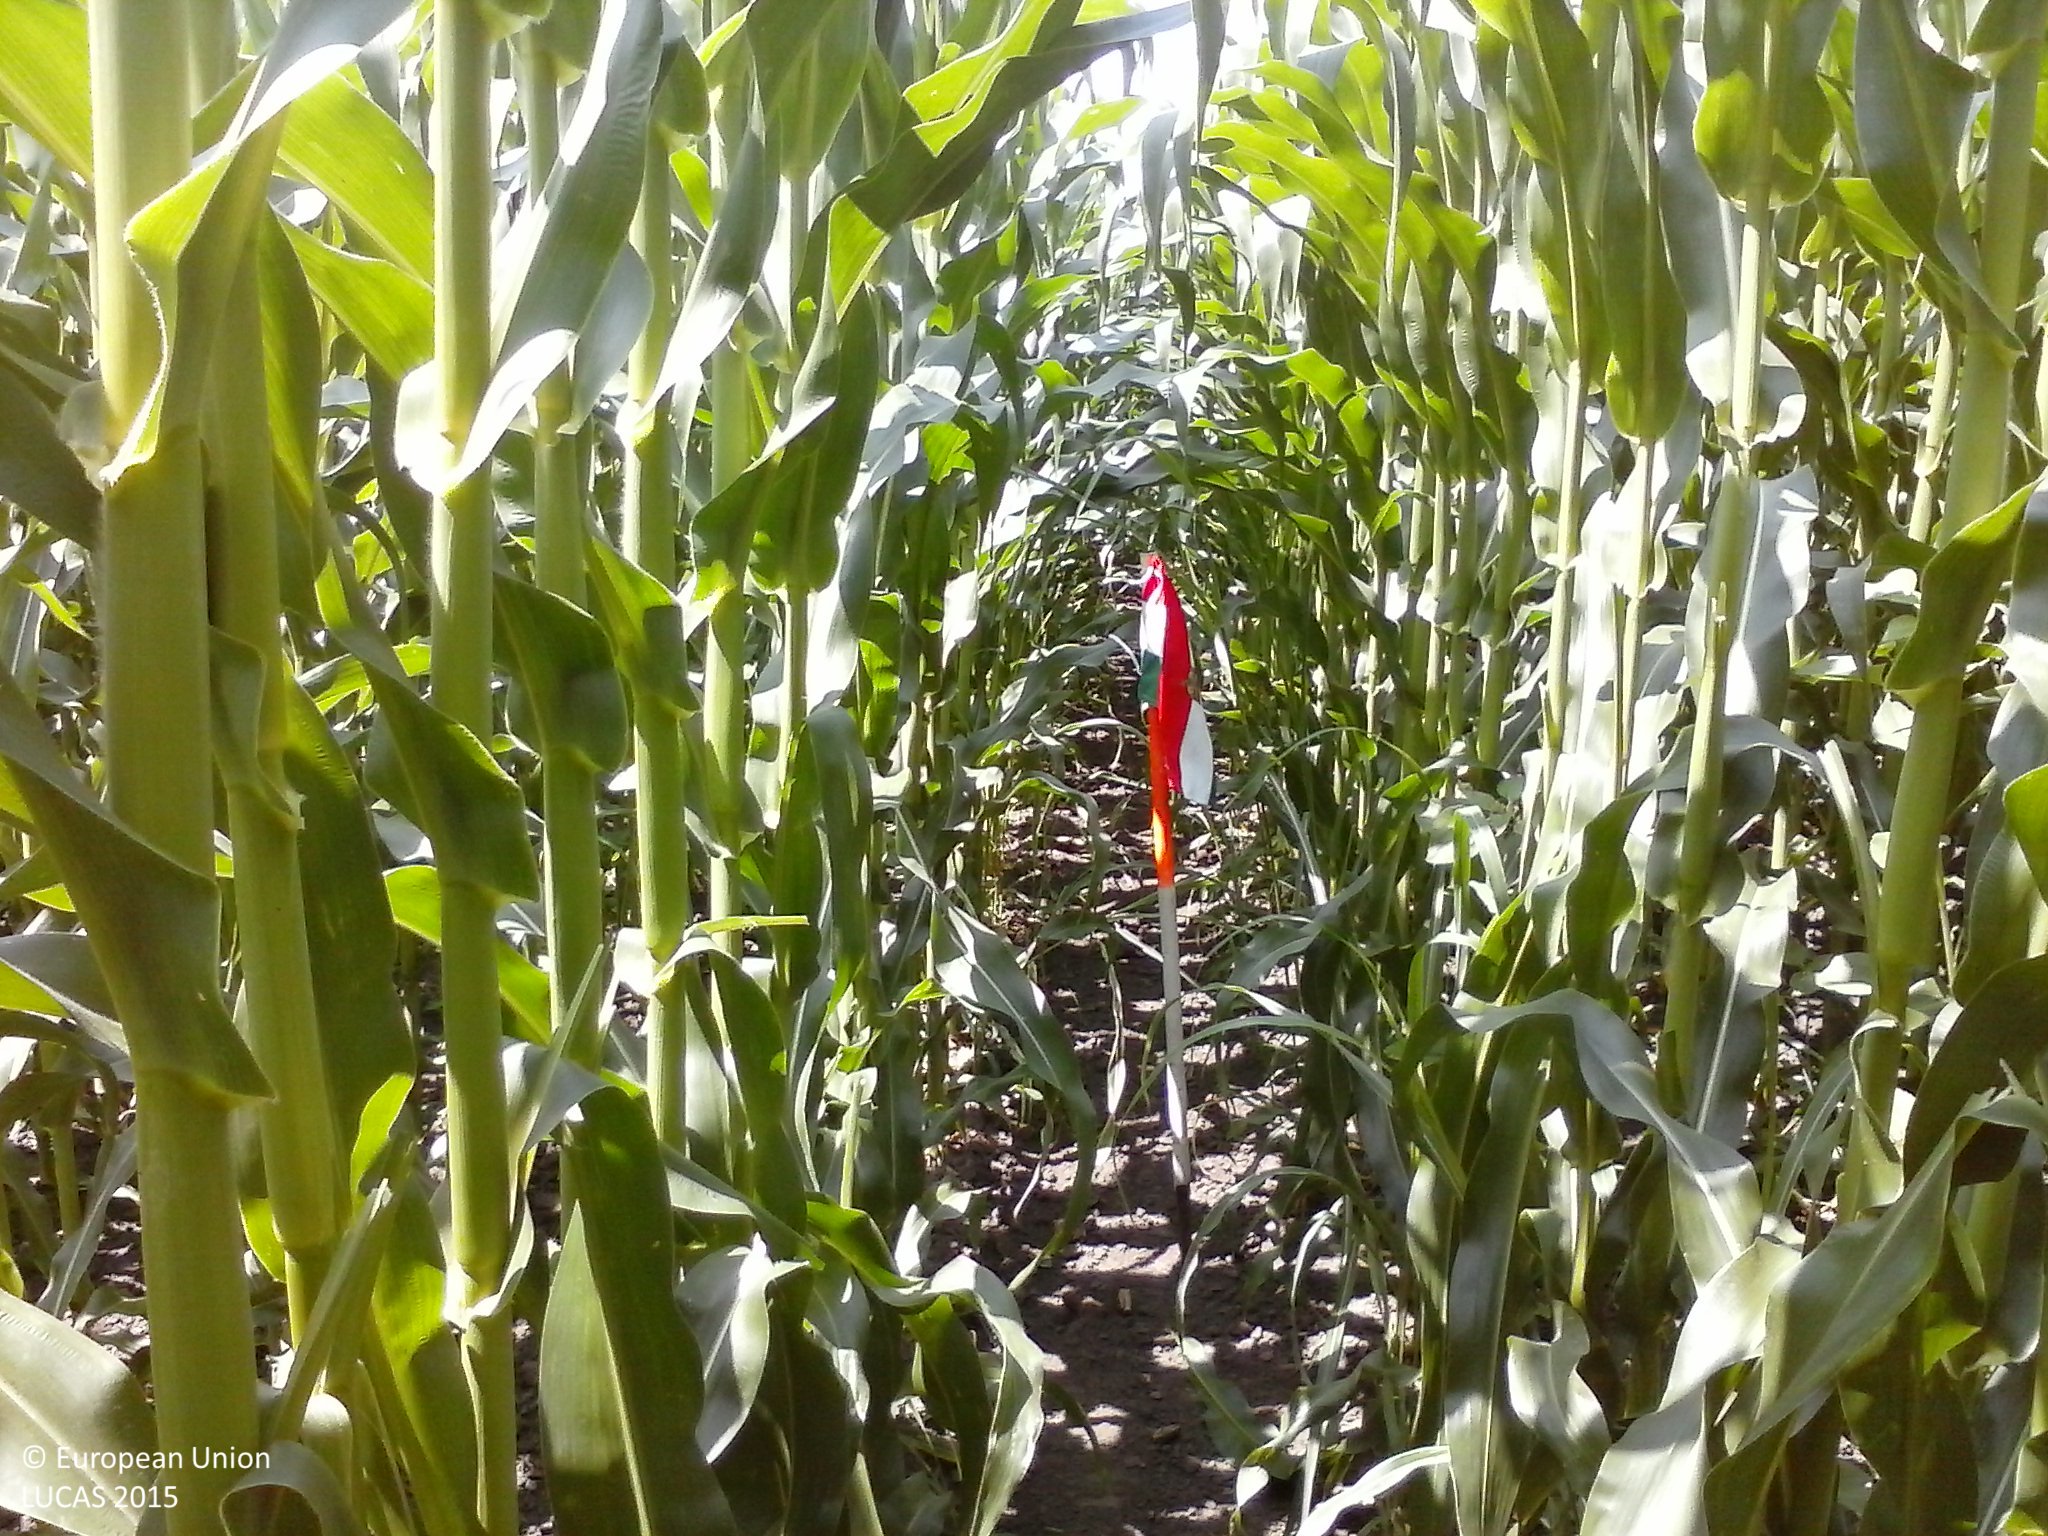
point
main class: Cropland
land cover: Maize
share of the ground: > 75 %
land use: Agriculture (excluding fallow land and kitchen gardens)
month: June
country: HU
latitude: 46.2183
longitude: 19.4925
